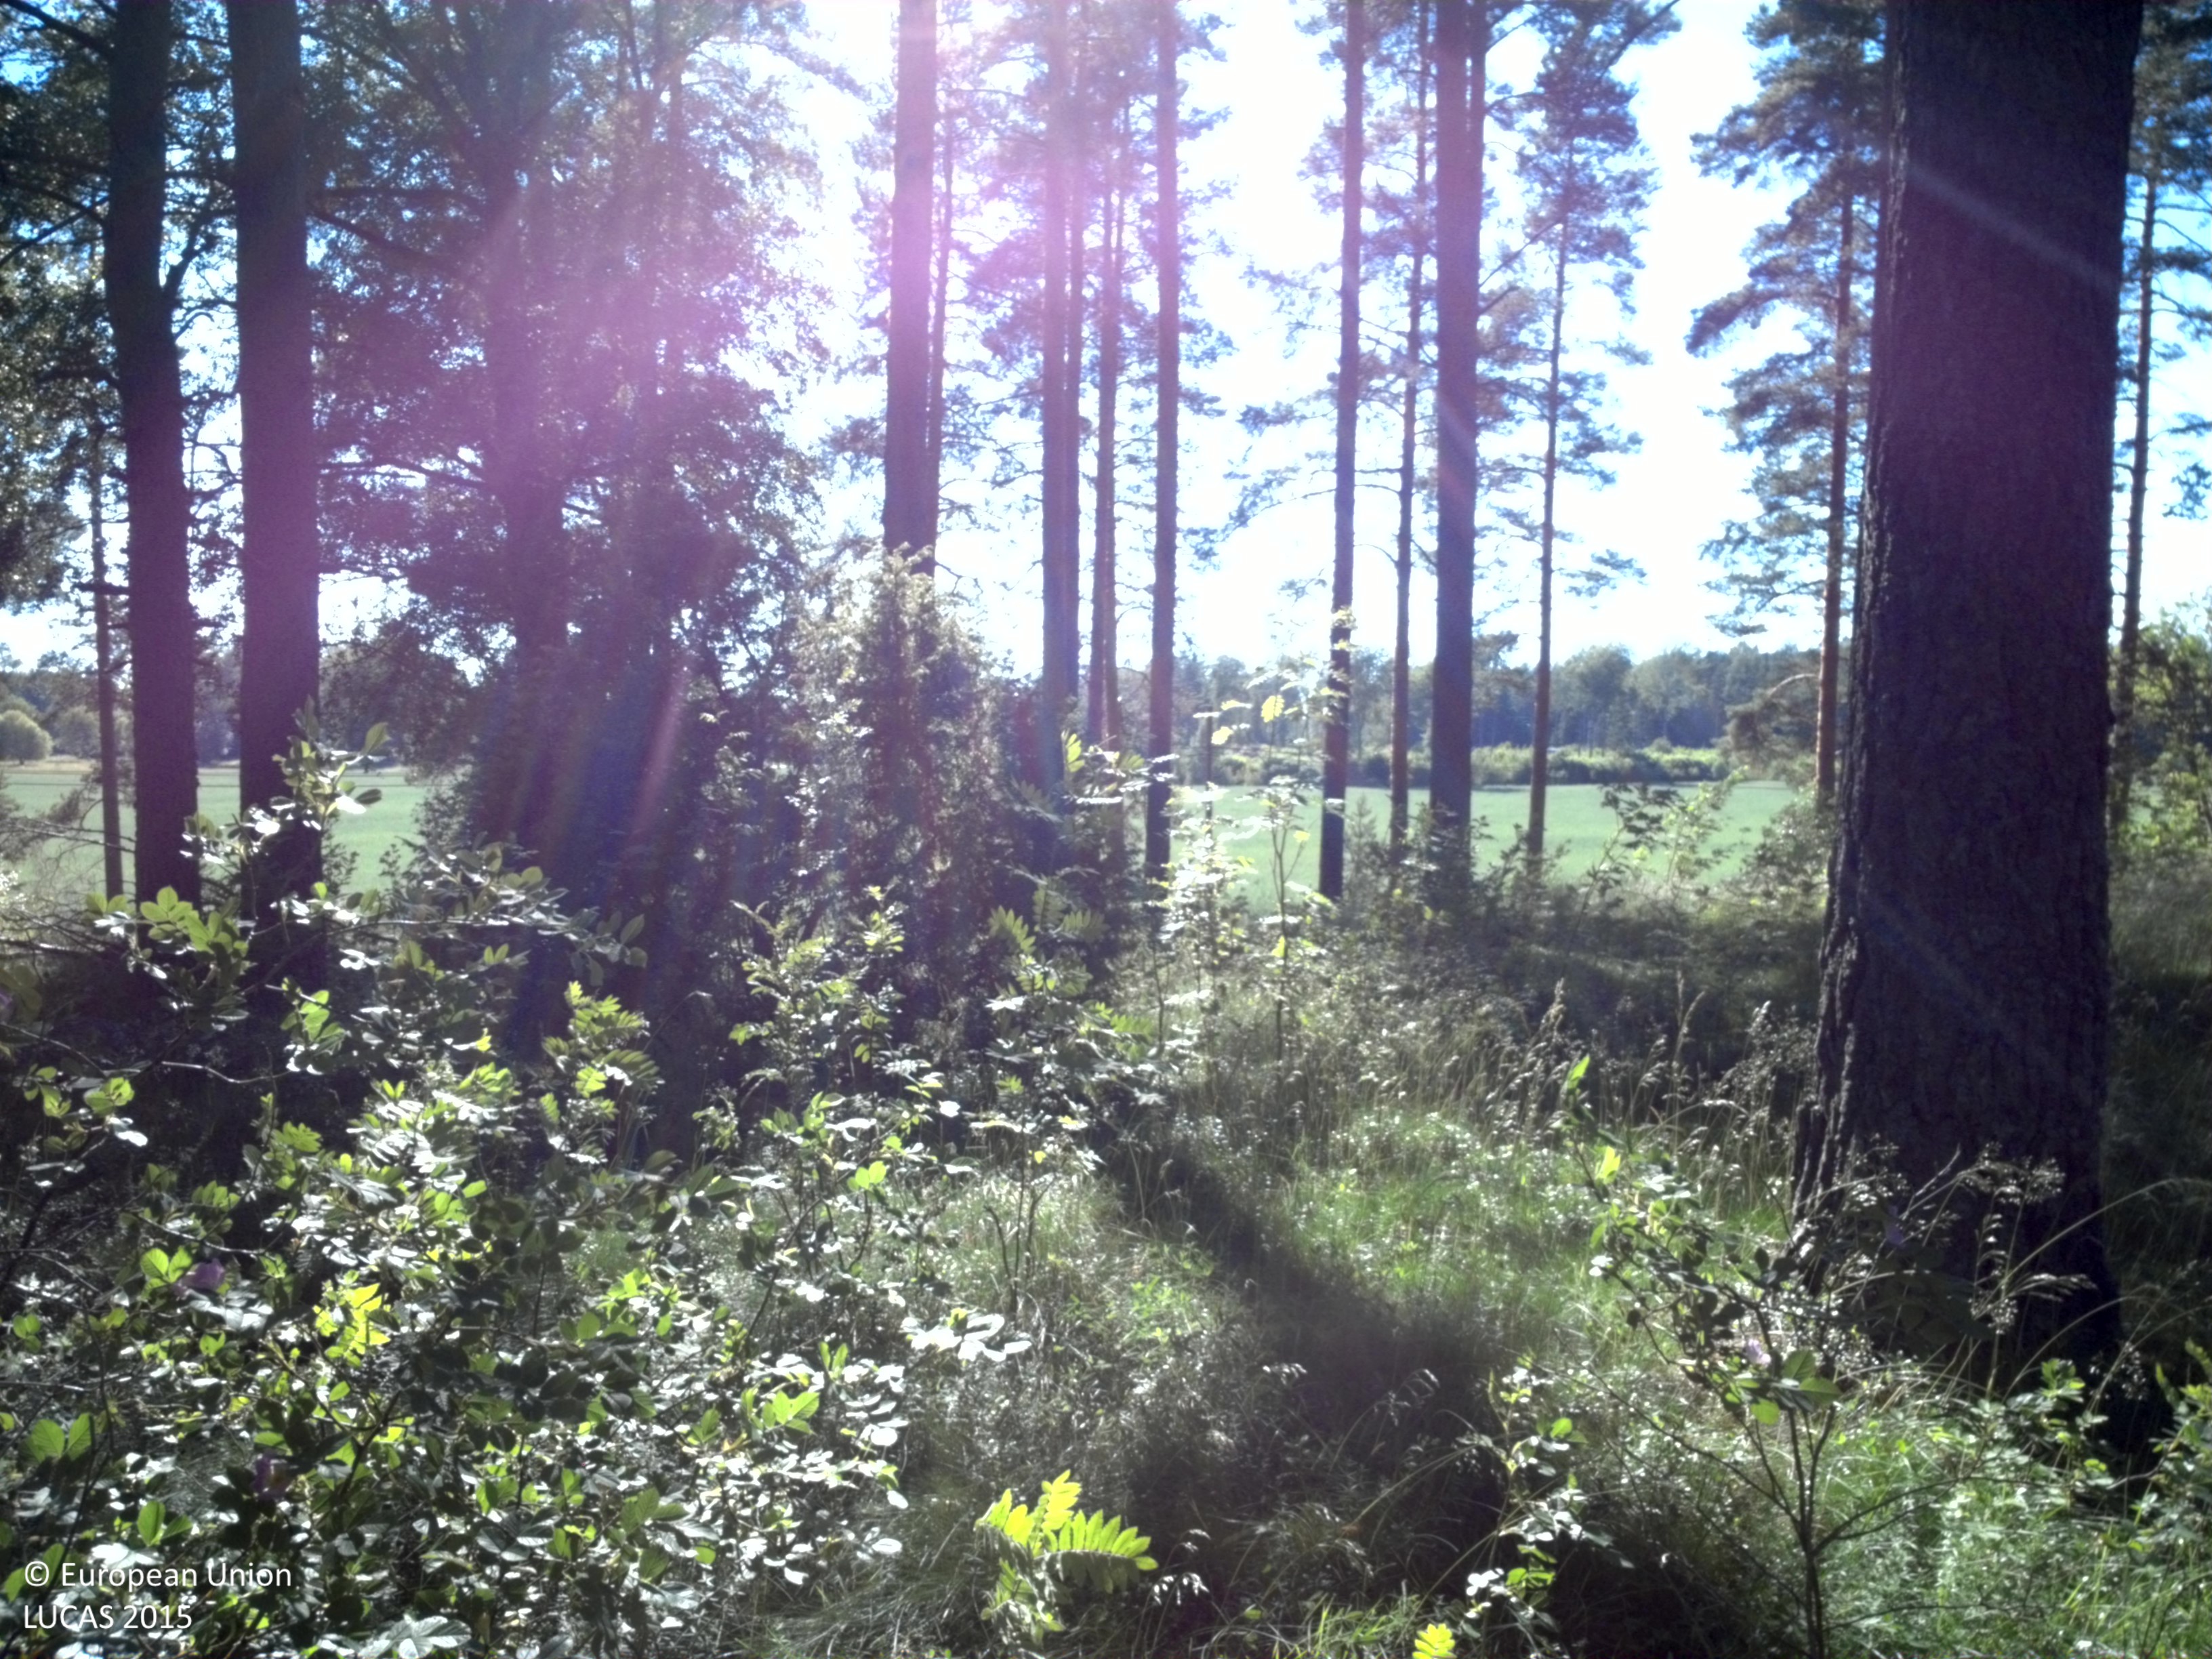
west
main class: Woodland
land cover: Pine dominated coniferous woodland
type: boreal forest
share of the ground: 50 - 75 %
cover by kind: coniferous forest trees 50 %, herbaceous plants 45 %, broadleaved forest trees 5 %
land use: Forestry
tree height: > 5 m
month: July
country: SE
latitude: 59.7436
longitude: 18.4859
